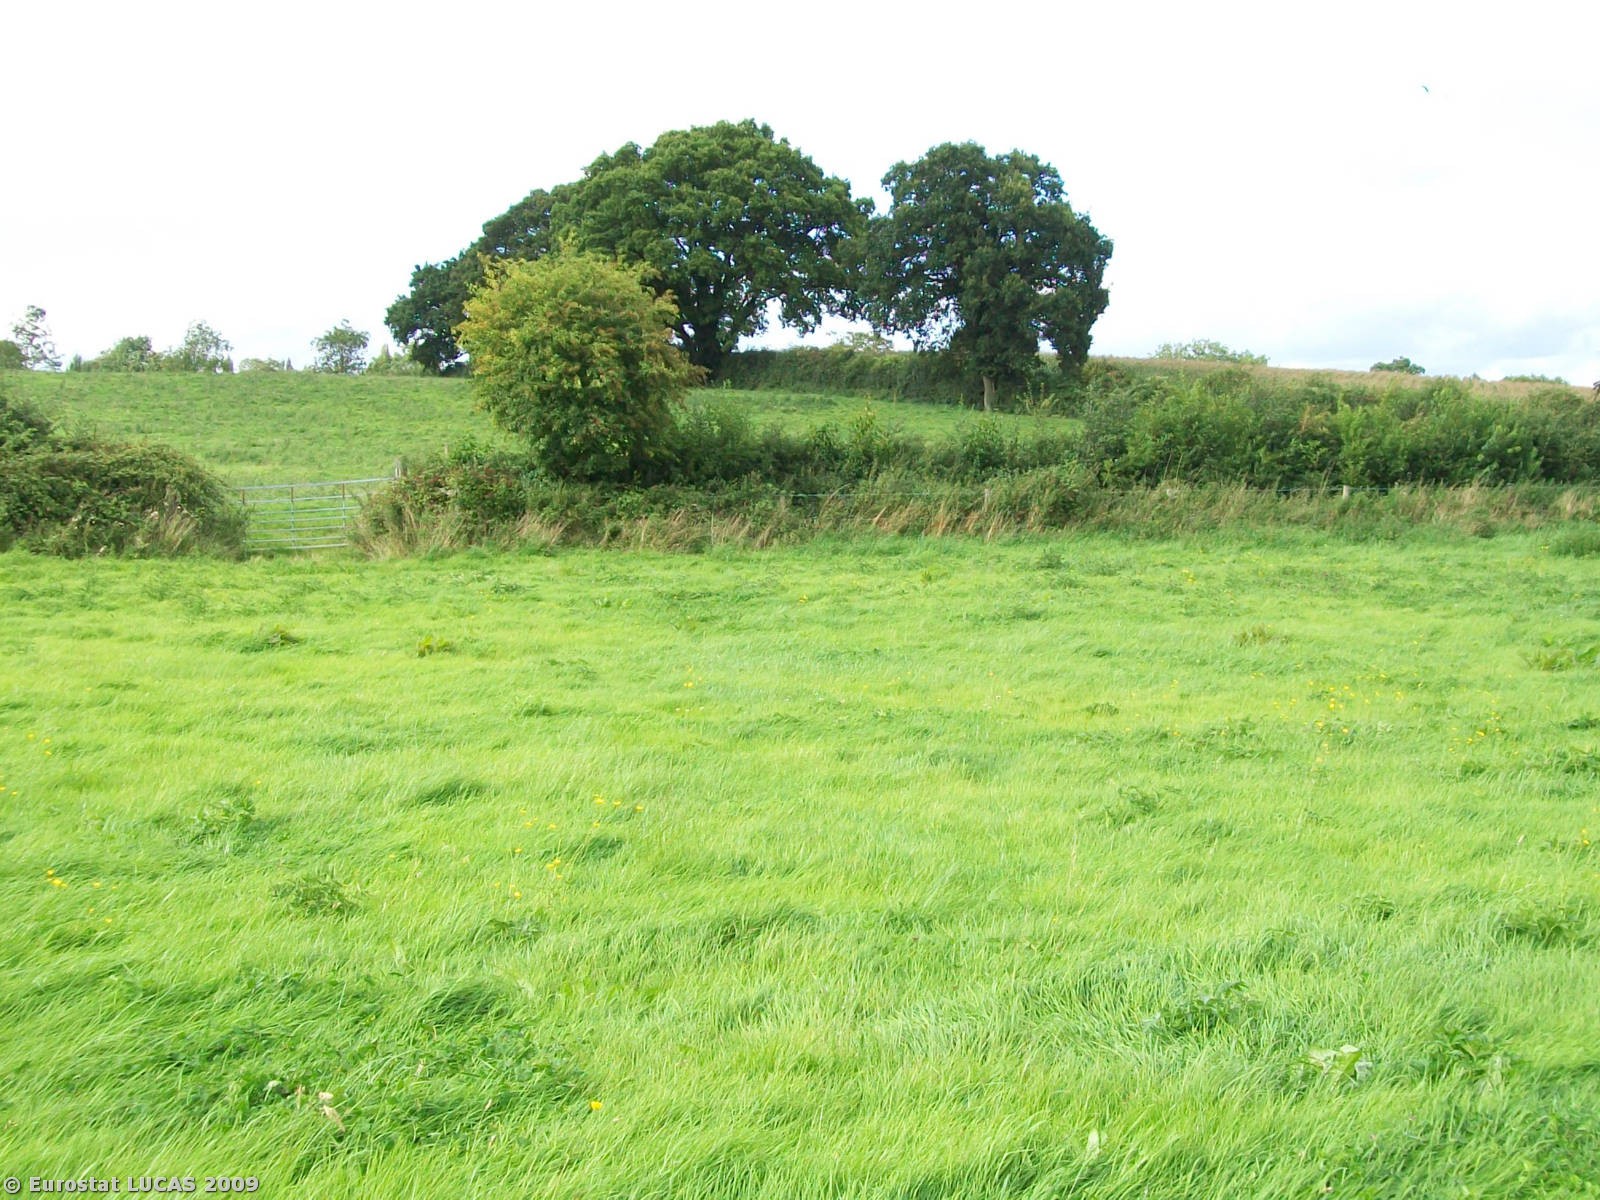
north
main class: Grassland
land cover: Grassland without tree/shrub cover
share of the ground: > 75 %
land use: Agriculture (excluding fallow land and kitchen gardens)
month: August
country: GB
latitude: 51.8879
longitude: -2.4004
